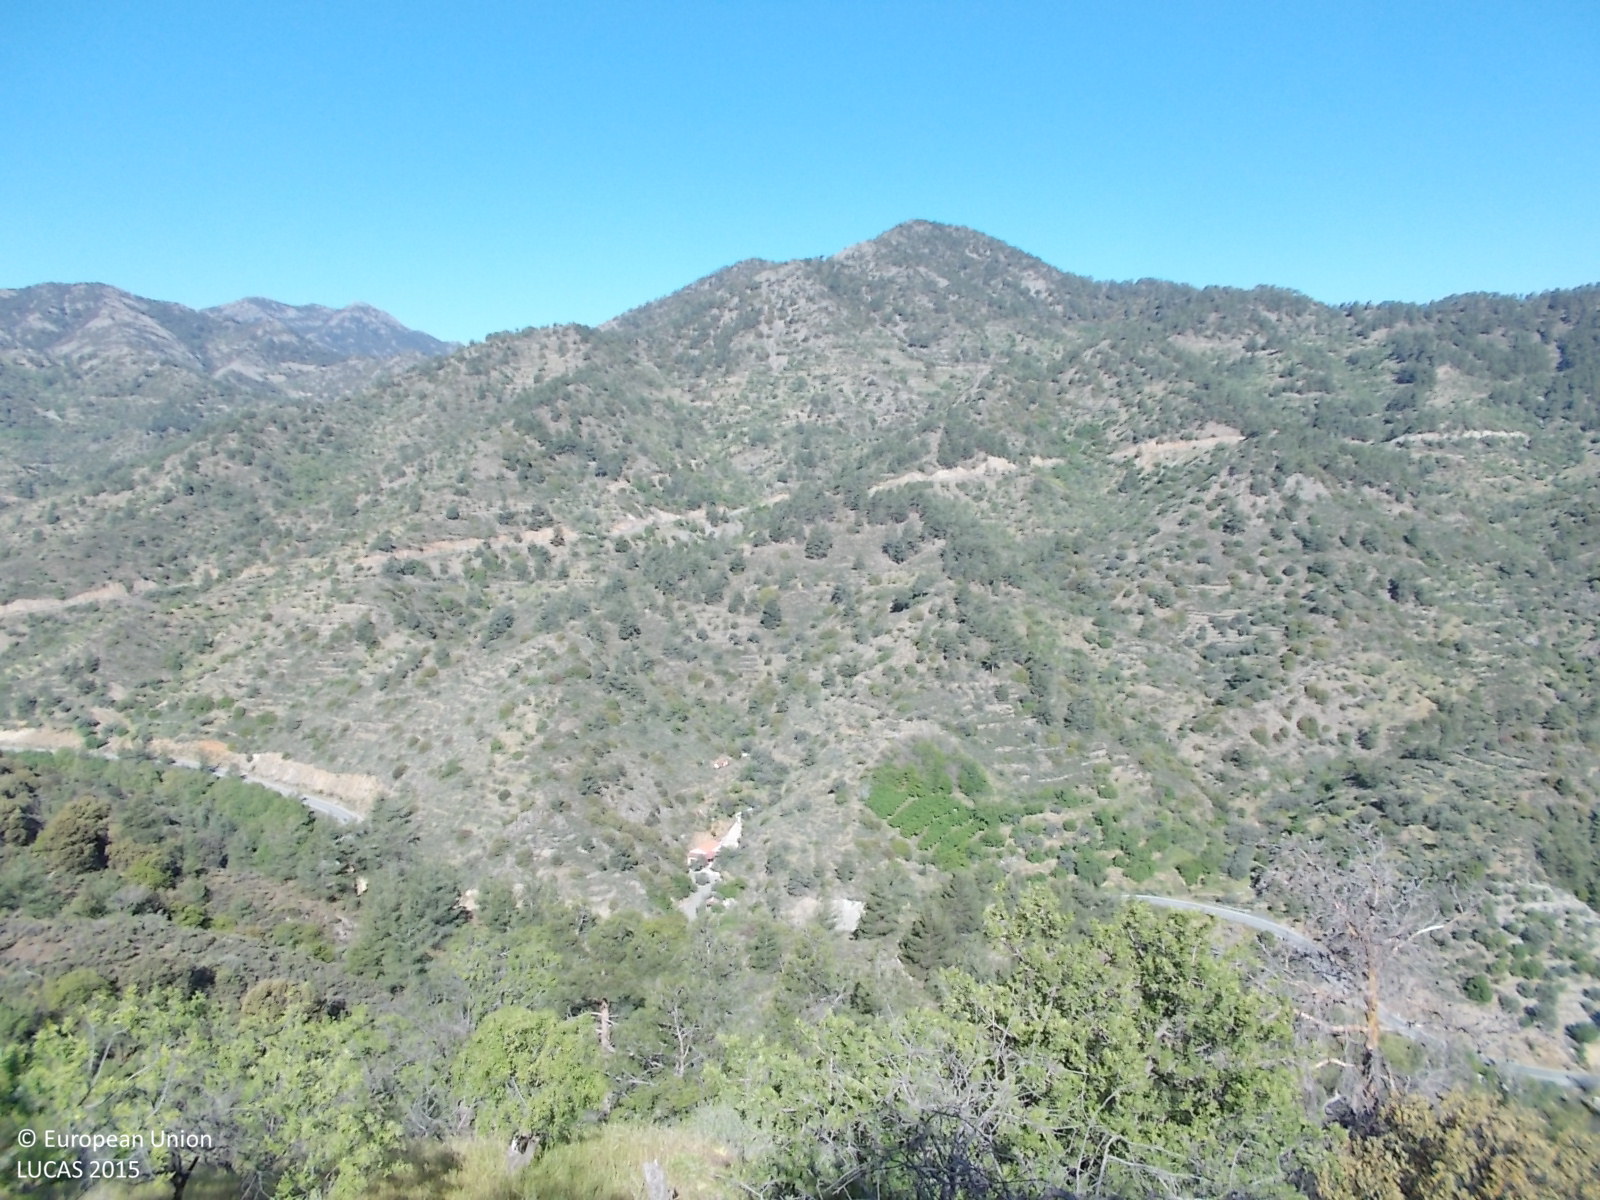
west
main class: Woodland
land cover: Pine dominated coniferous woodland
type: coniferous forest of the mediterranean region
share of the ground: > 75 %
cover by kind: coniferous forest trees 100 %
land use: Semi-natural and natural areas not in use
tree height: > 5 m
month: May
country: CY
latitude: 34.9676
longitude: 33.0545
